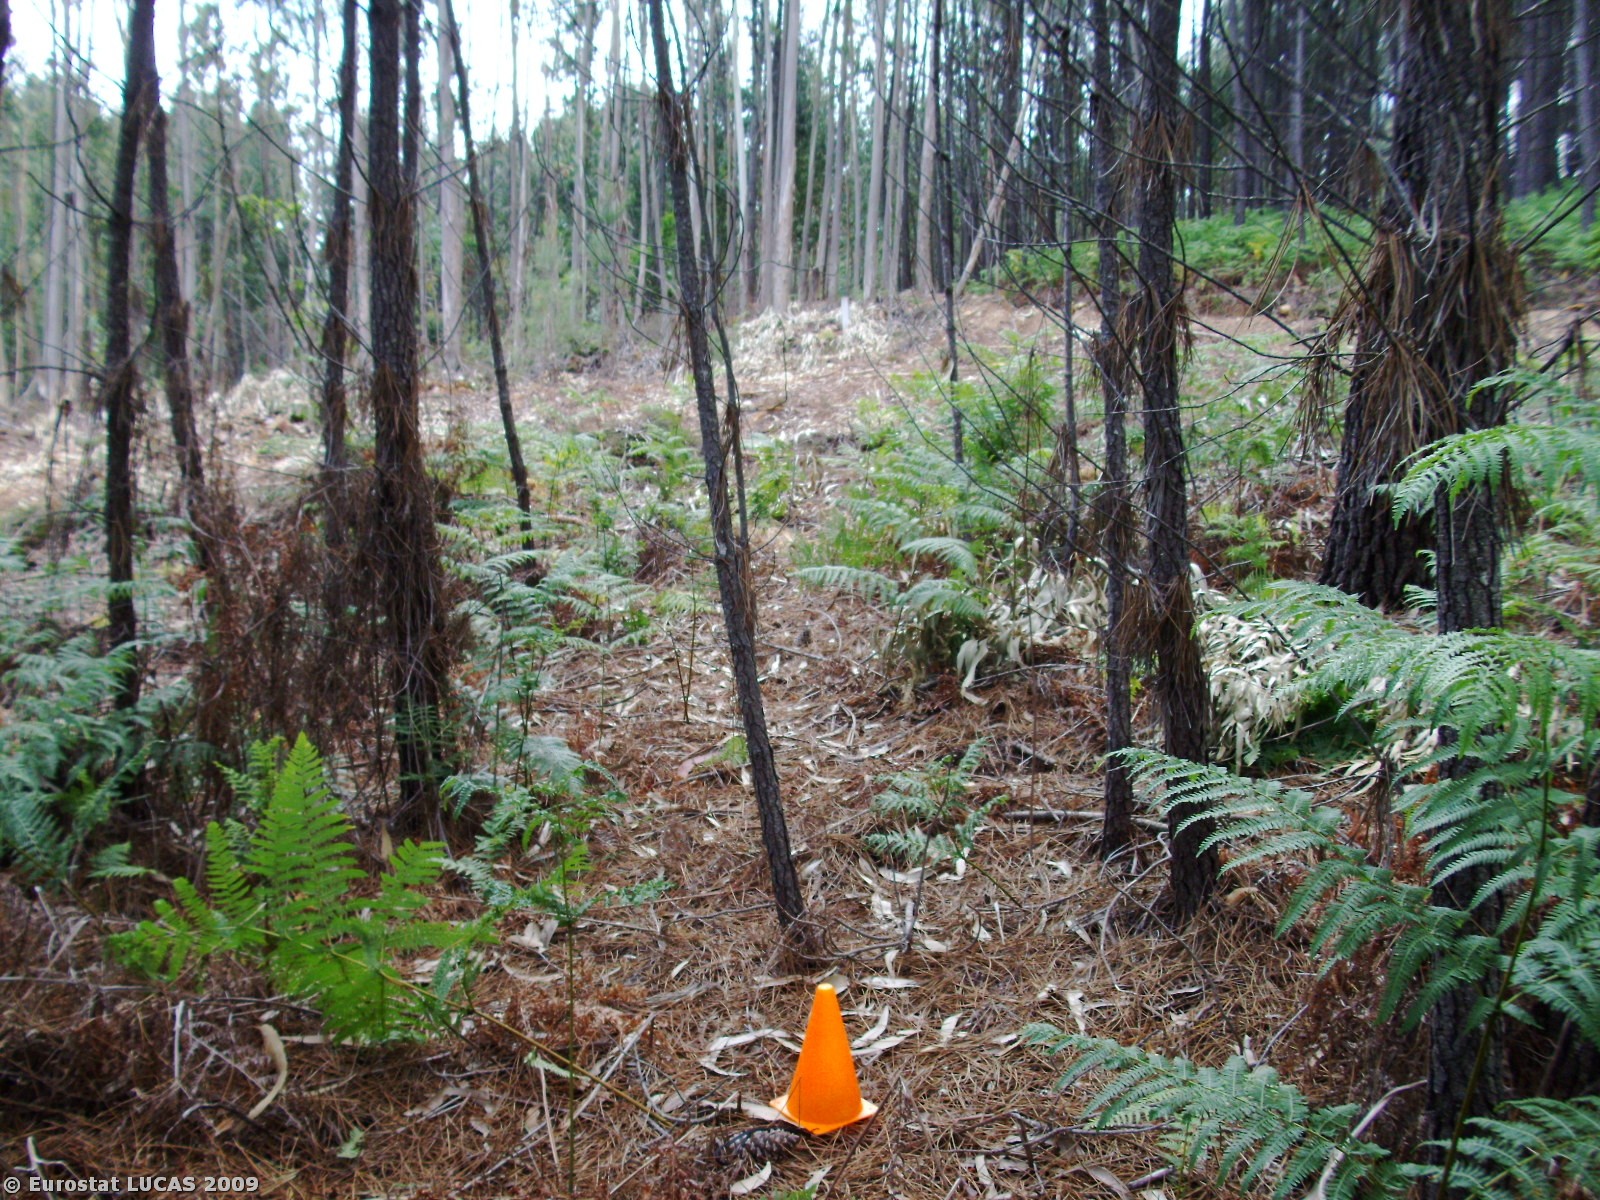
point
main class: Woodland
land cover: Coniferous woodland
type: coniferous forest of the mediterranean region
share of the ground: 50 - 75 %
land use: Forestry
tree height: > 5 m
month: June
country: PT
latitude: 39.9533
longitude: -8.3006
